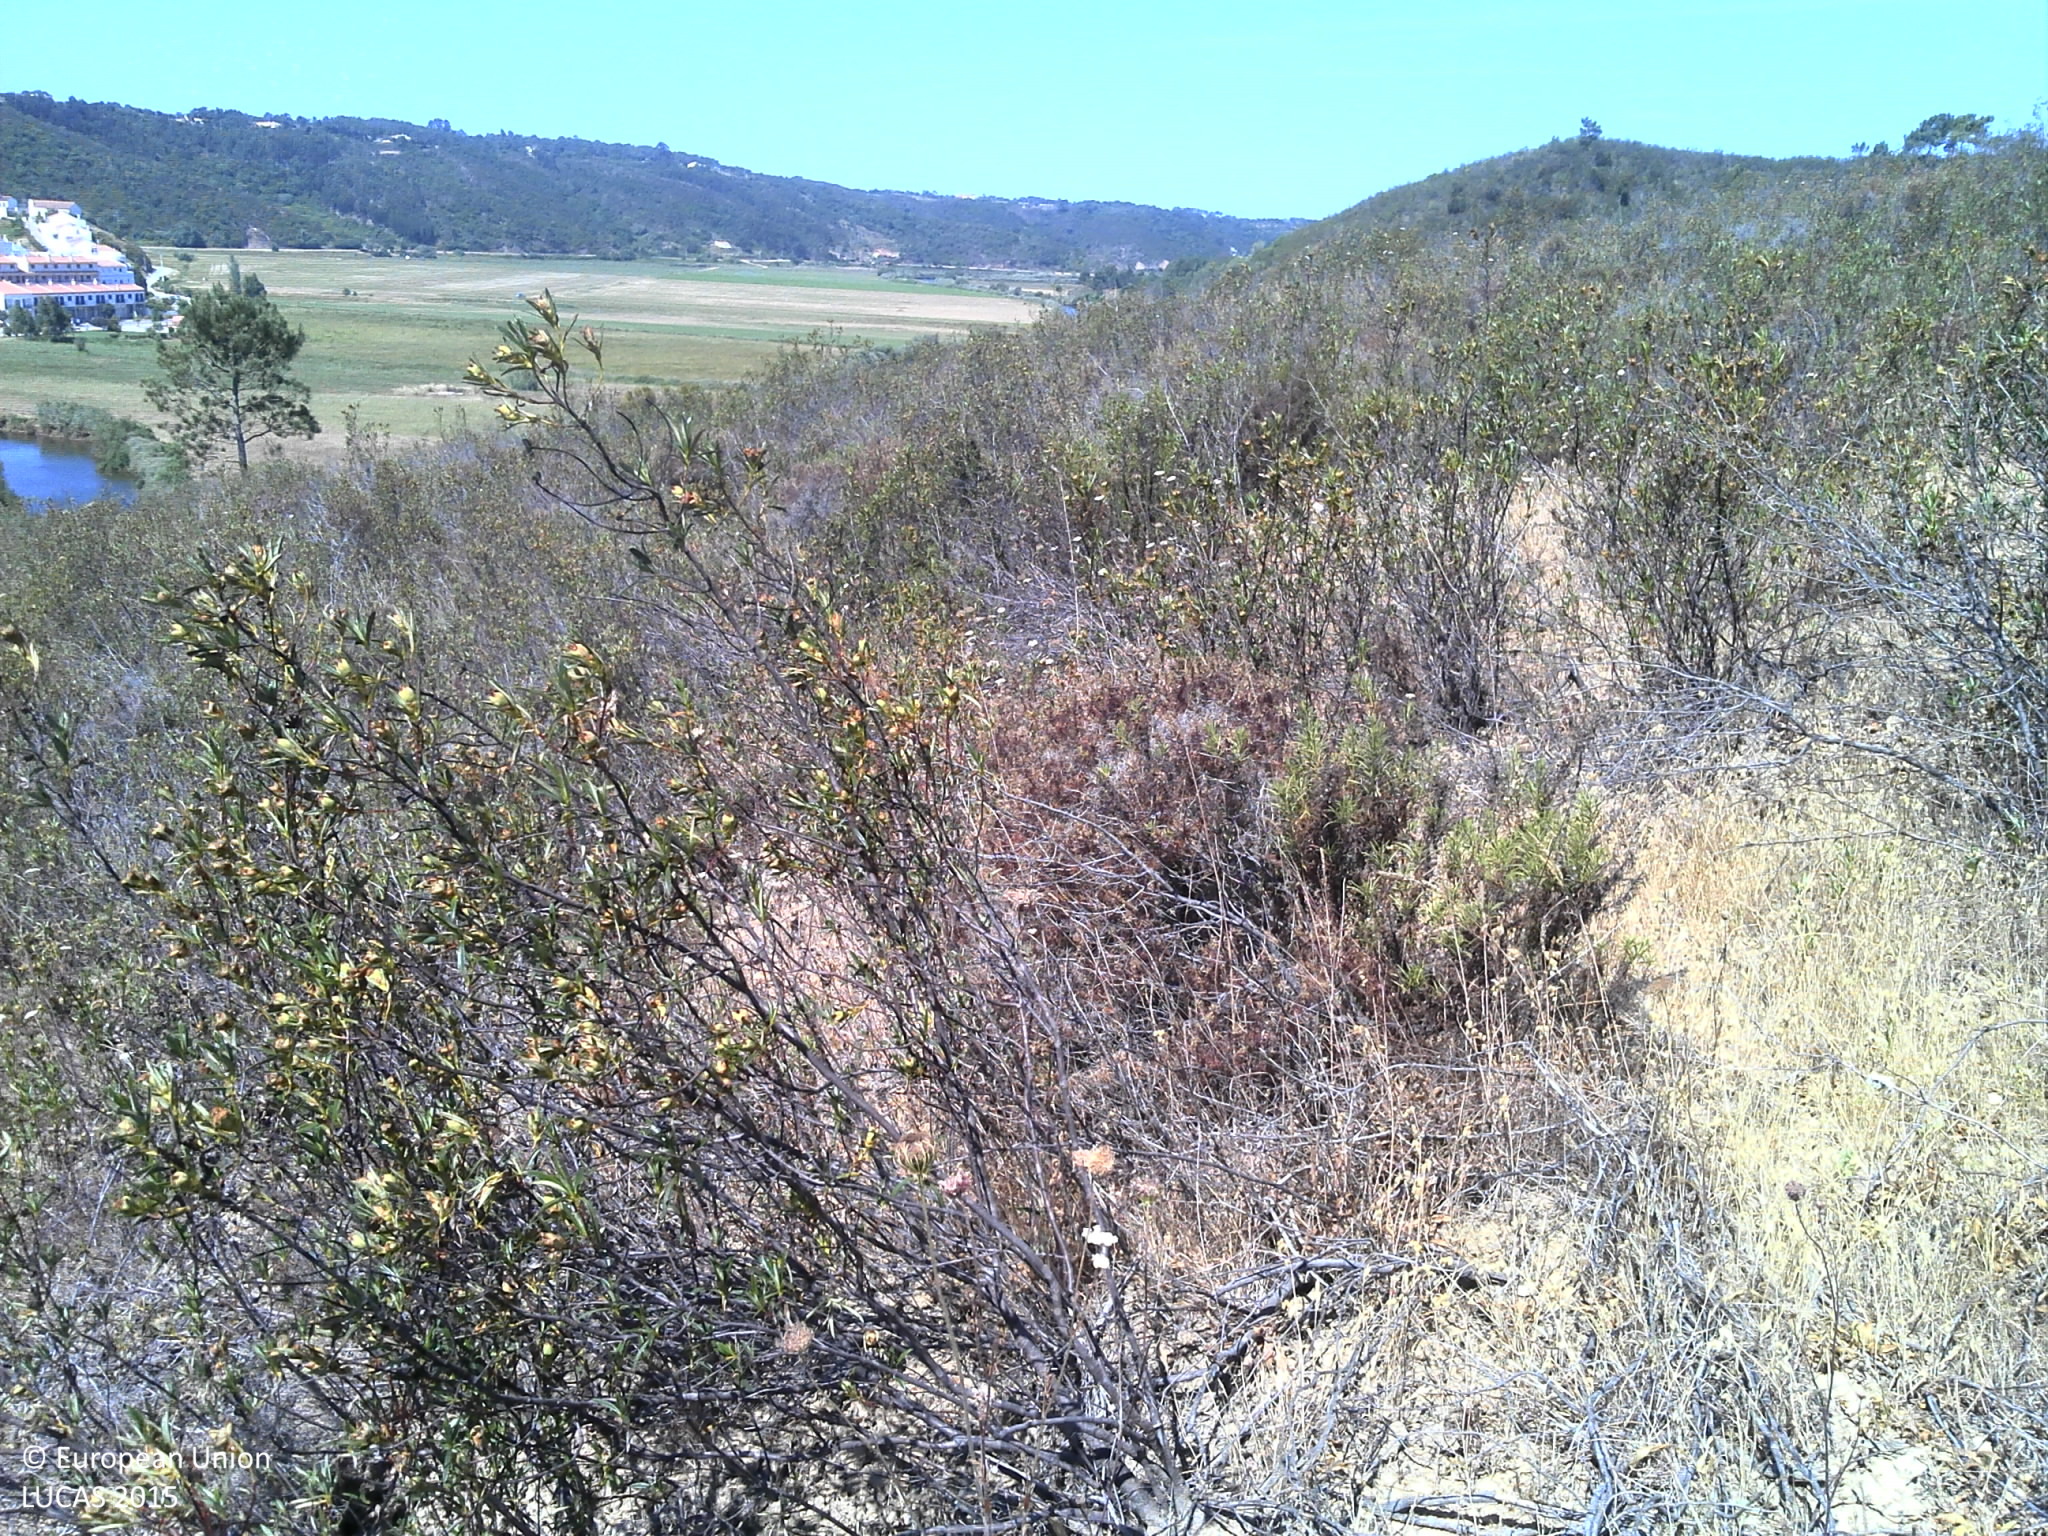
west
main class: Shrubland
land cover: Shrubland without tree cover
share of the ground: > 75 %
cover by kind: shrubs 80 %, unconsolidated bare surface 20 %
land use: Abandoned areas
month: June
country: PT
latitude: 37.4376
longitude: -8.7655
